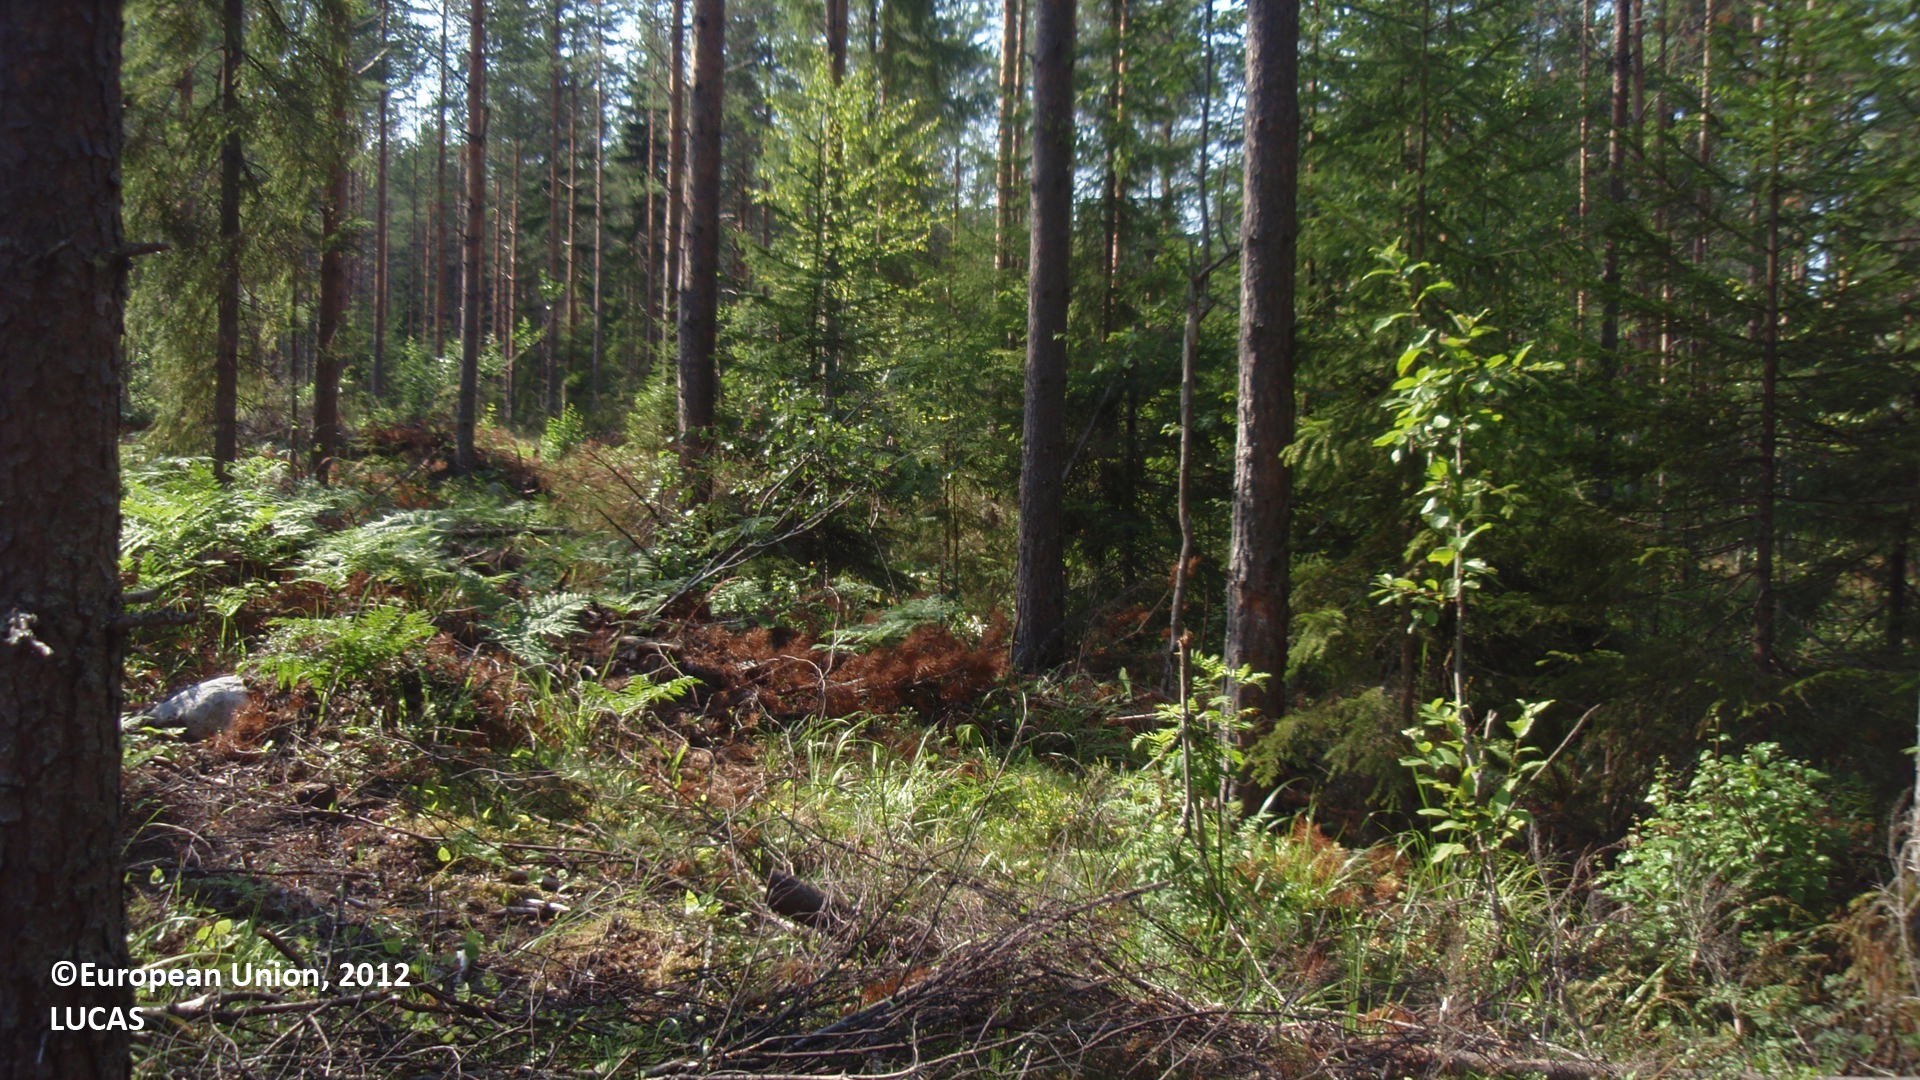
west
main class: Woodland
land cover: Pine dominated coniferous woodland
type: boreal forest
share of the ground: 50 - 75 %
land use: Forestry
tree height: > 5 m
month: July
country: FI
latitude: 61.3889
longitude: 28.3861
